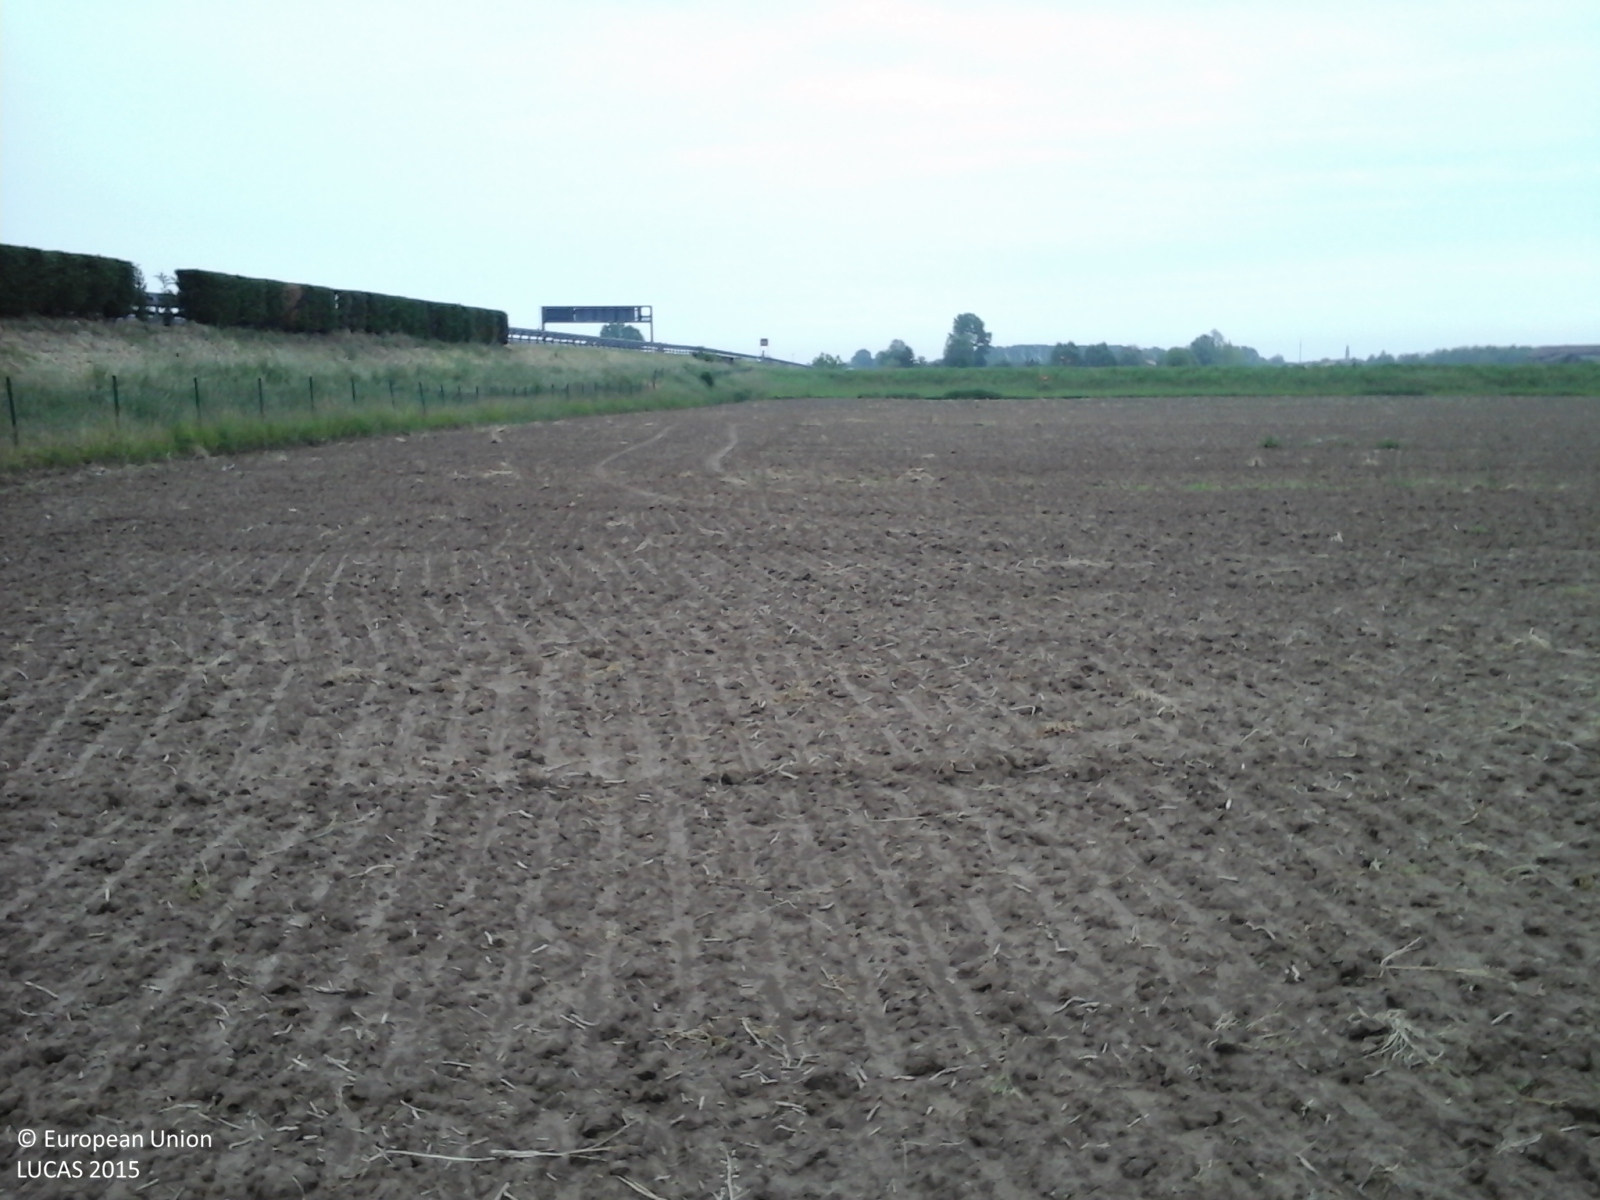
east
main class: Cropland
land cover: Maize
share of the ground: < 10 %
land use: Agriculture (excluding fallow land and kitchen gardens)
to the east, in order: Maize; Fences; Ditches and canals; Grassland without tree/shrub cover; Conifer hedges; Paved roads, cycling and walking lanes; Grassland without tree/shrub cover; Fences; Single bushes/trees; Inland fresh running water; Grassland without tree/shrub cover
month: May
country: IT
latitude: 45.4723
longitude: 11.7240
